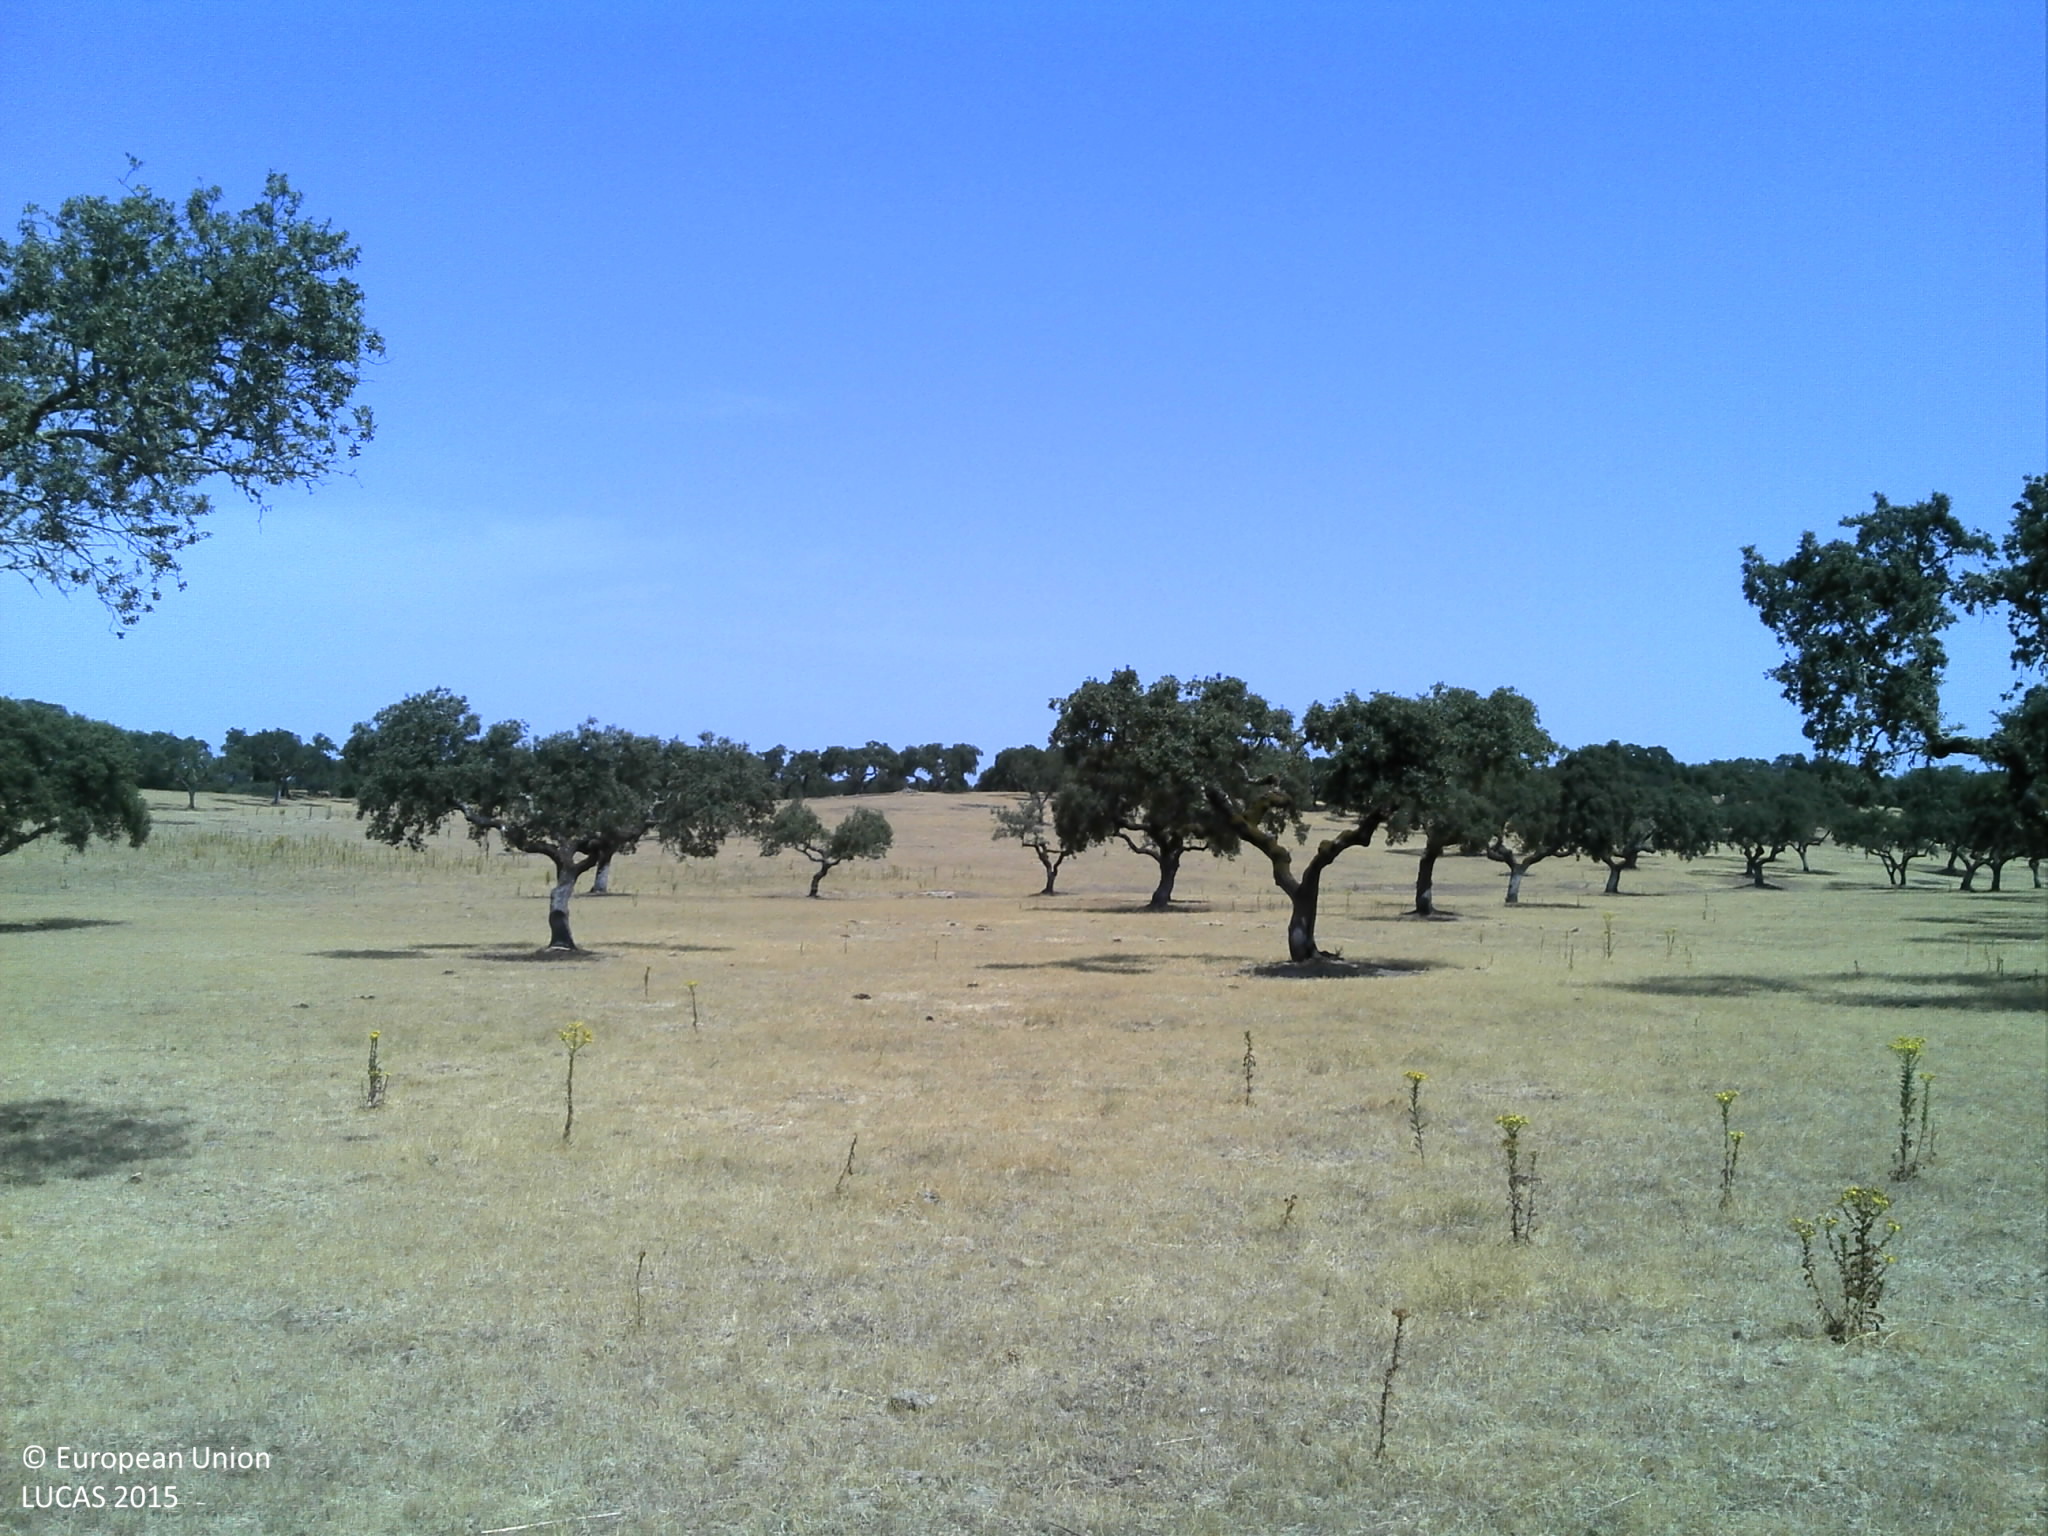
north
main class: Woodland
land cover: Broadleaved woodland
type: broadleaved evergreen forest
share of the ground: 10 - 25 %
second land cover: Grassland without tree/shrub cover
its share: 50 - 75 %
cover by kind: herbaceous plants 60 %, unconsolidated bare surface 25 %, broadleaved forest trees 15 %
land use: Forestry
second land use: Agriculture (excluding fallow land and kitchen gardens)
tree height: > 5 m
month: July
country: PT
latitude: 38.6972
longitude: -7.7093
